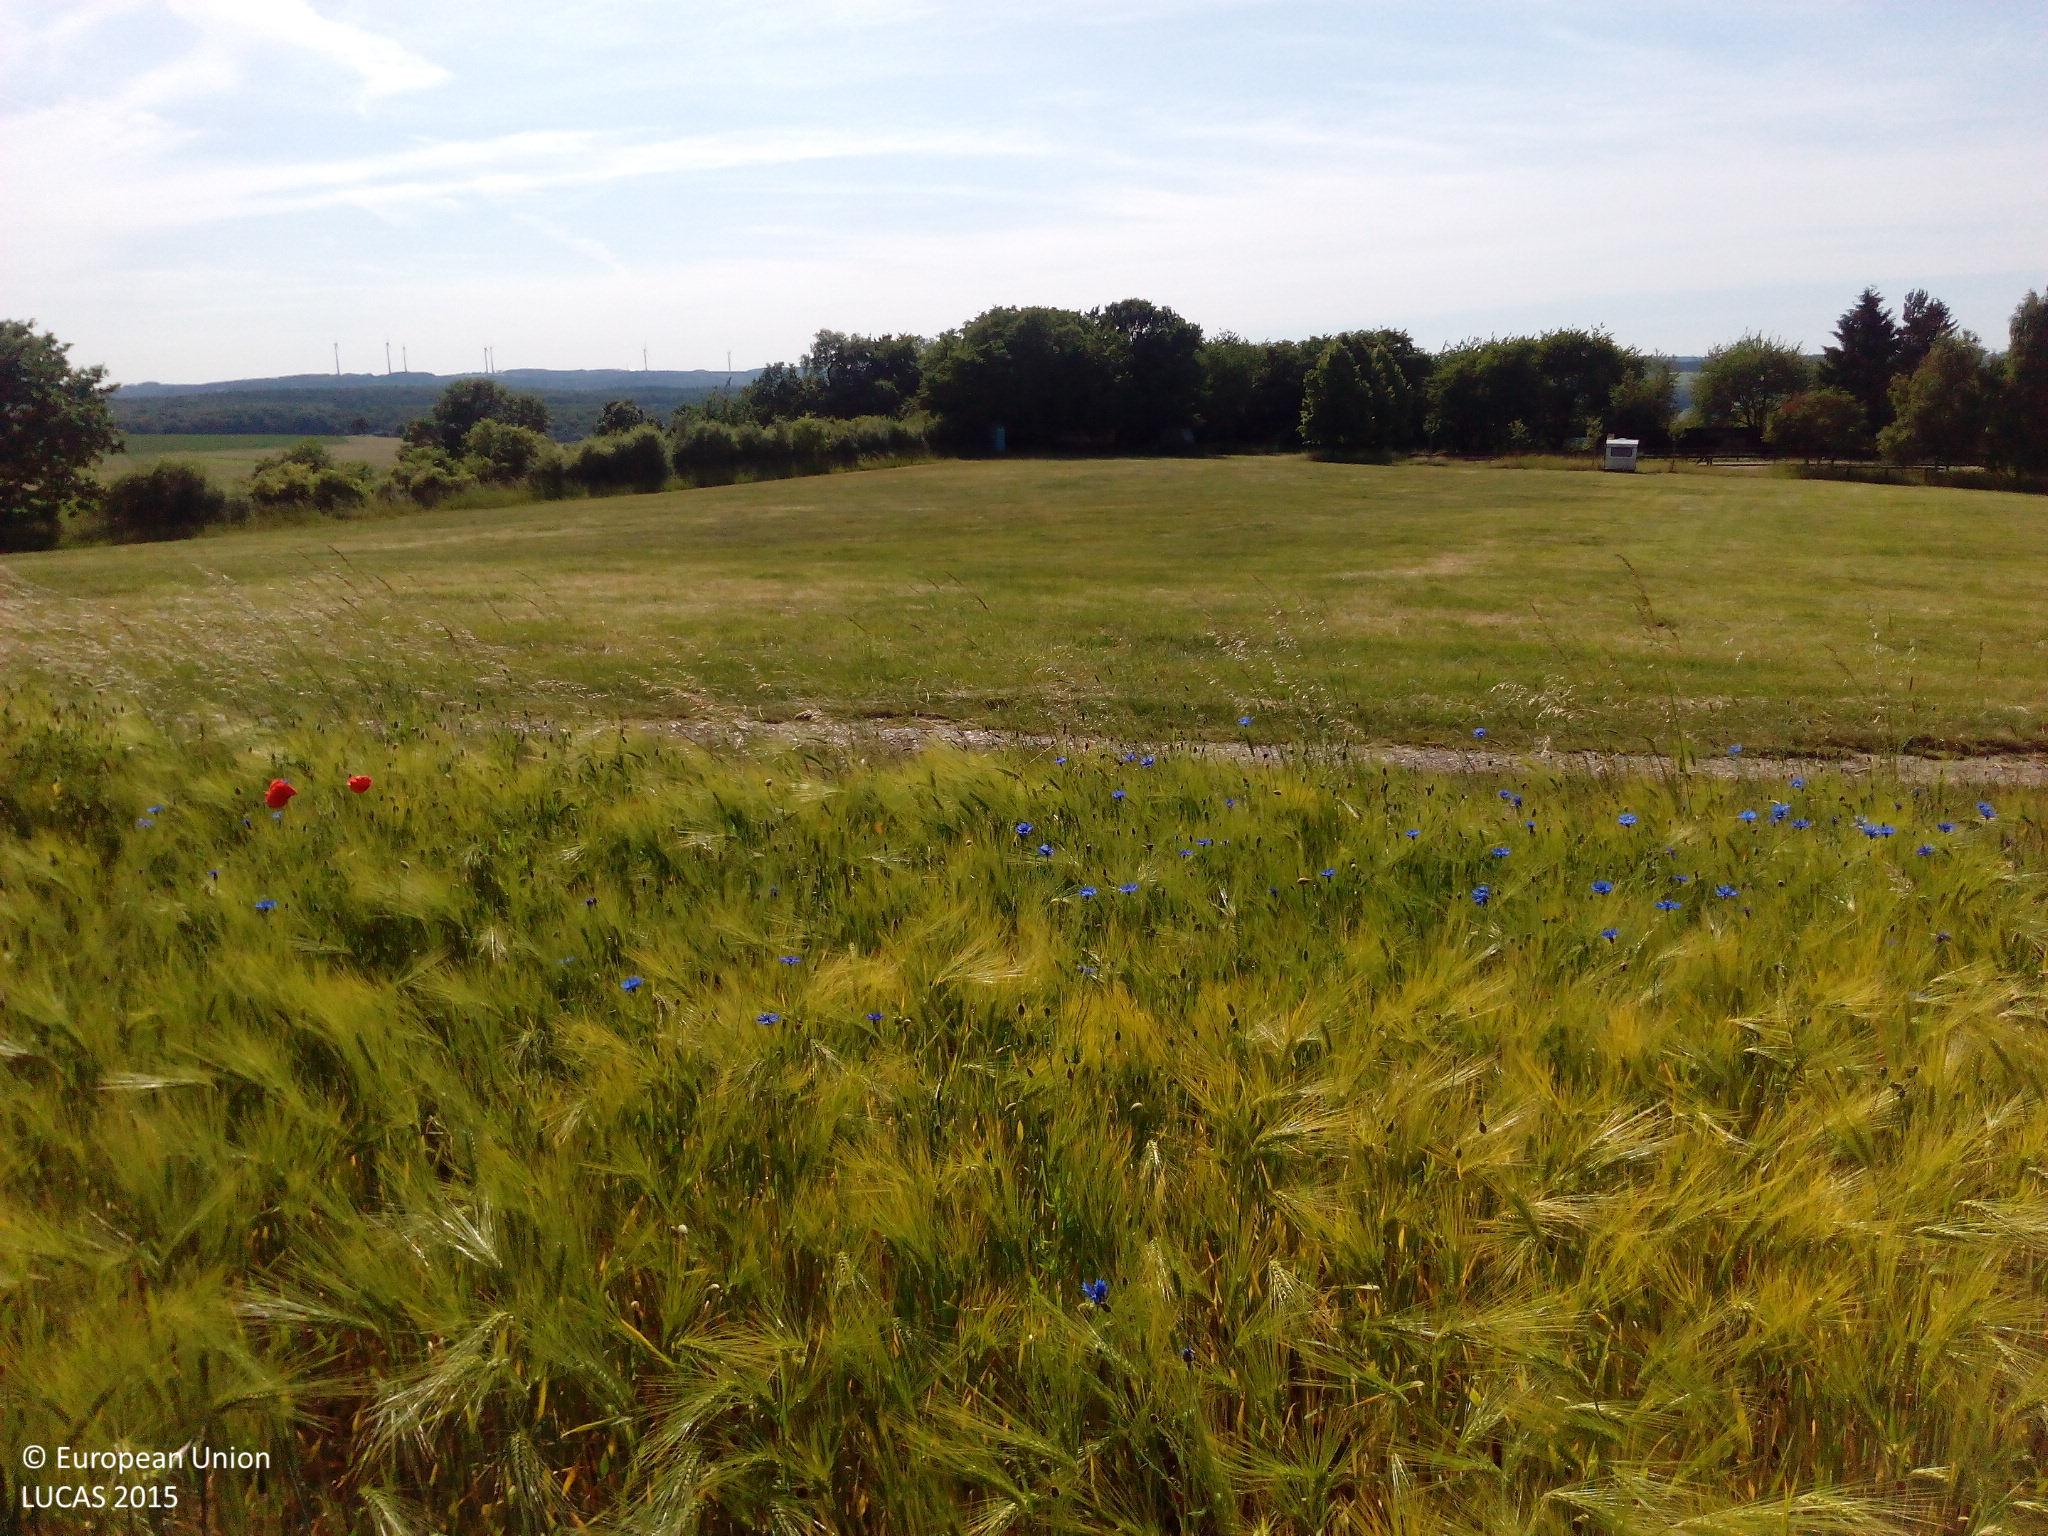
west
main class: Cropland
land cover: Barley
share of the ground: > 75 %
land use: Agriculture (excluding fallow land and kitchen gardens)
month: June
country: DE
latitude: 50.1870
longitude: 8.1376
